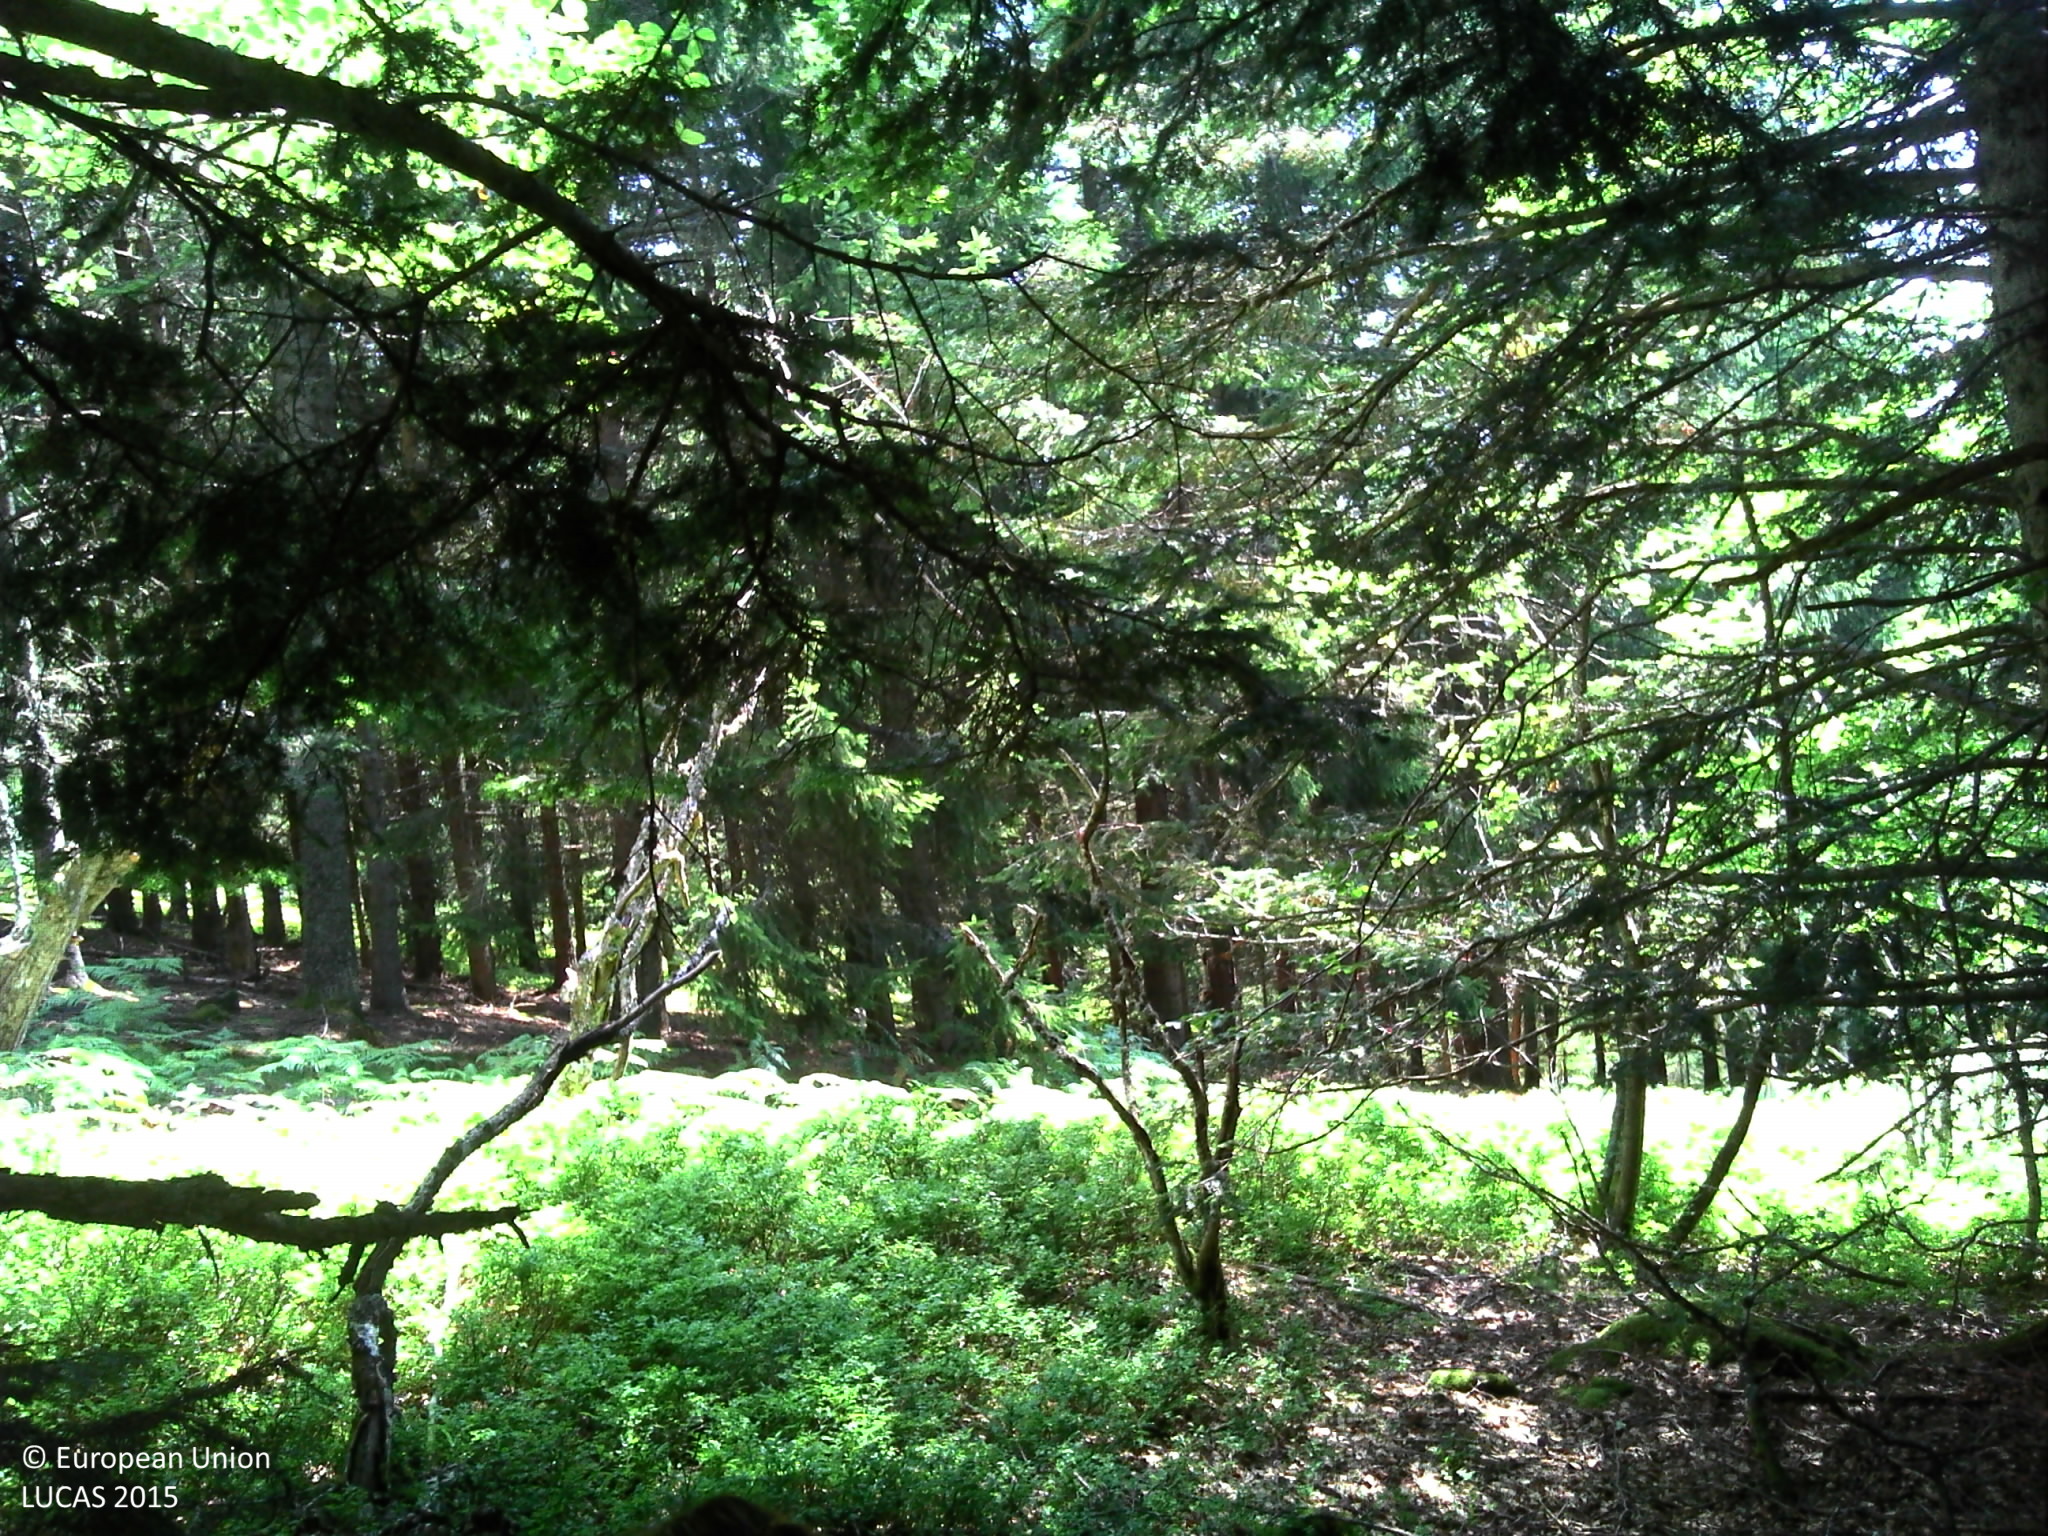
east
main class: Woodland
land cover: Spruce dominated mixed woodland
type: mountainous beech forest
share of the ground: > 75 %
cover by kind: coniferous forest trees 35 %, broadleaved forest trees 35 %, shrubs 10 %, herbaceous plants 10 %, lichens and mosses 10 %
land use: Forestry
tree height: > 5 m
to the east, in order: Spruce dominated mixed woodland; Shrubland without tree cover; Spruce dominated mixed woodland; Shrubland without tree cover; Spruce dominated mixed woodland; Shrubland with sparse tree cover
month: August
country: FR
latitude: 45.3844
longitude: 4.6019
